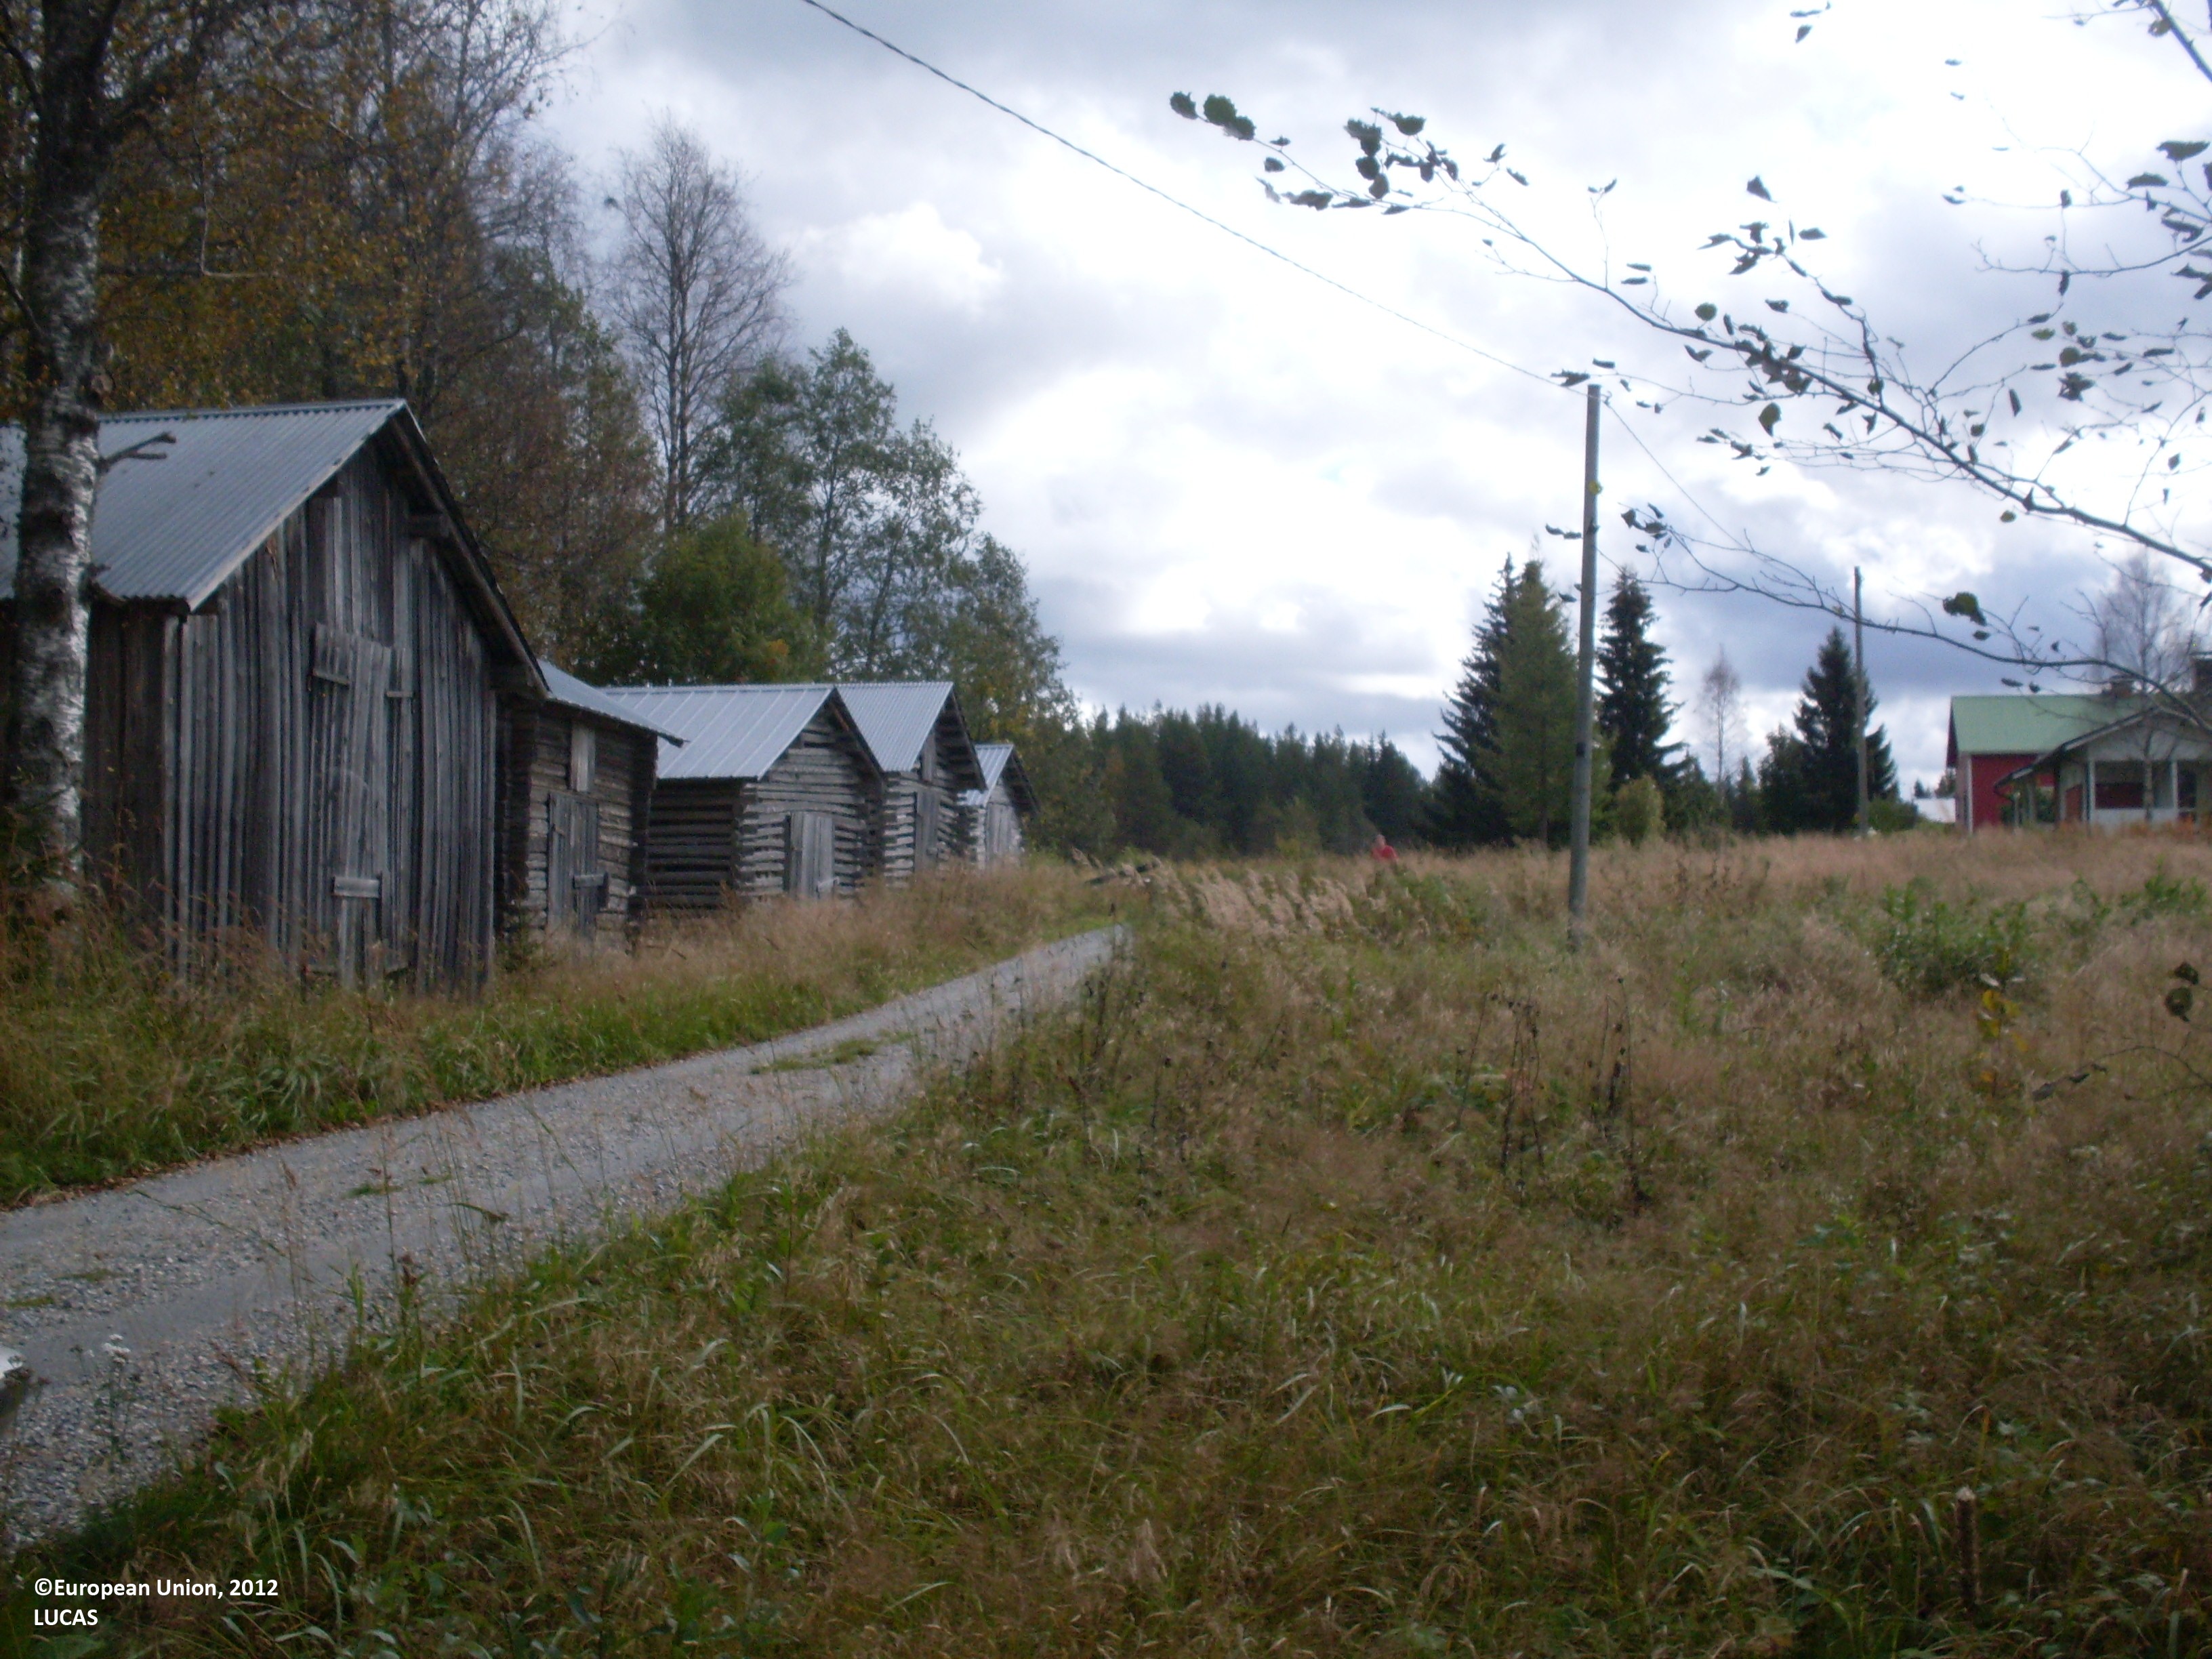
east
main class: Grassland
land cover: Grassland without tree/shrub cover
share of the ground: > 75 %
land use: Agriculture (excluding fallow land and kitchen gardens)
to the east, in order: Grassland without tree/shrub cover; Electric lines; Grassland without tree/shrub cover; Paved roads, cycling and walking lanes; Spruce dominated mixed woodland; Grassland without tree/shrub cover; Ditches and canals; Grassland without tree/shrub cover; Ditches and canals; Spruce dominated mixed woodland
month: September
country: FI
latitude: 64.2554
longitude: 28.2676
